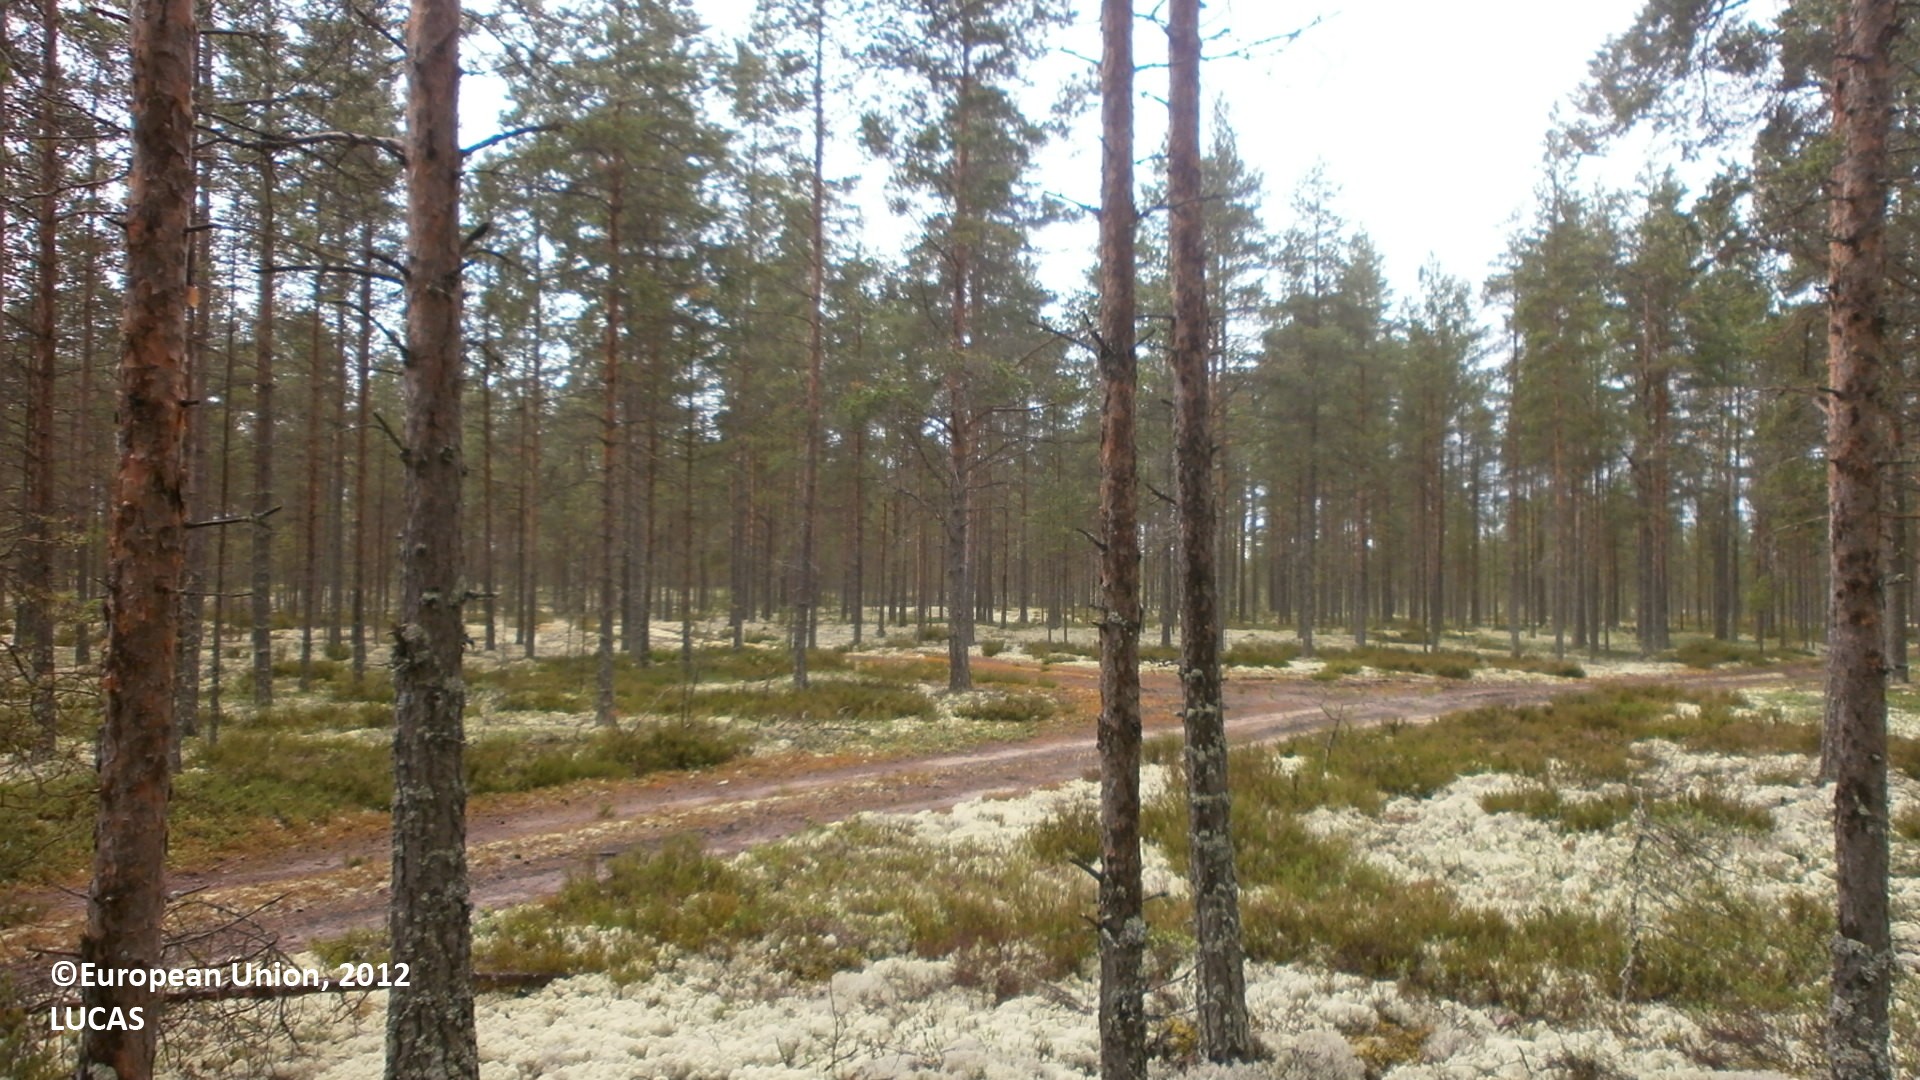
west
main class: Woodland
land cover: Pine dominated coniferous woodland
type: boreal forest
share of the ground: 50 - 75 %
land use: Forestry
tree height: > 5 m
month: July
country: FI
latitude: 64.1368
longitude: 23.8479
